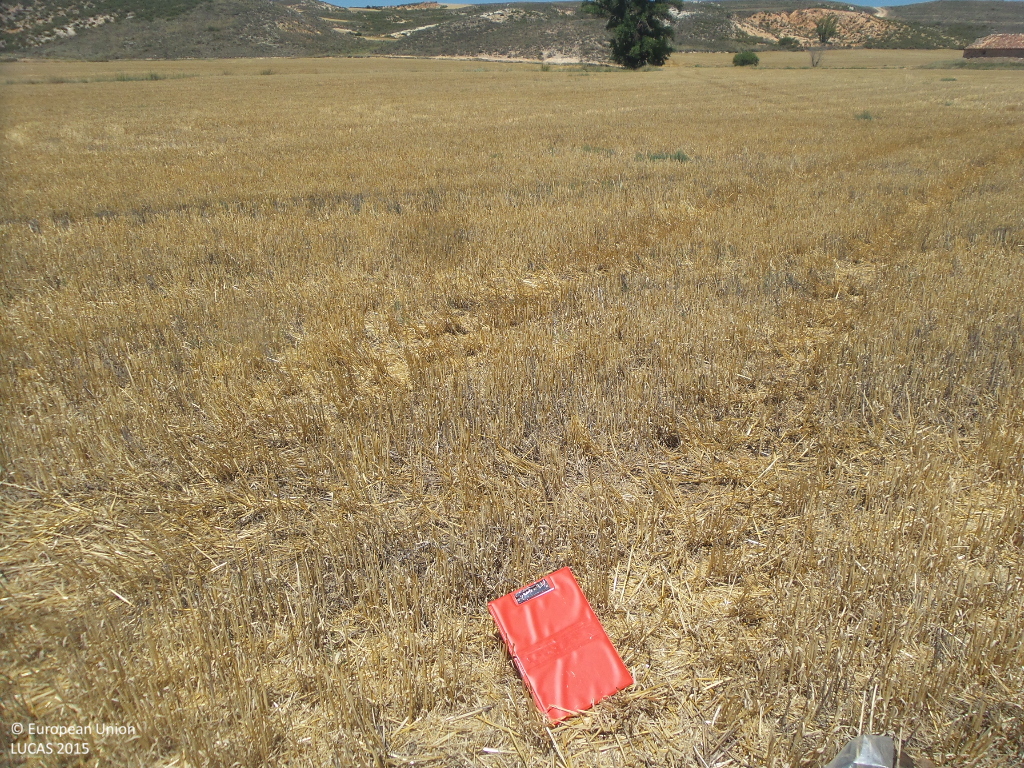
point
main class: Cropland
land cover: Barley
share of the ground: < 10 %
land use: Agriculture (excluding fallow land and kitchen gardens)
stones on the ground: < 10 %
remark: Harvested field
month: July
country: ES
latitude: 41.4325
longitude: -2.1053
